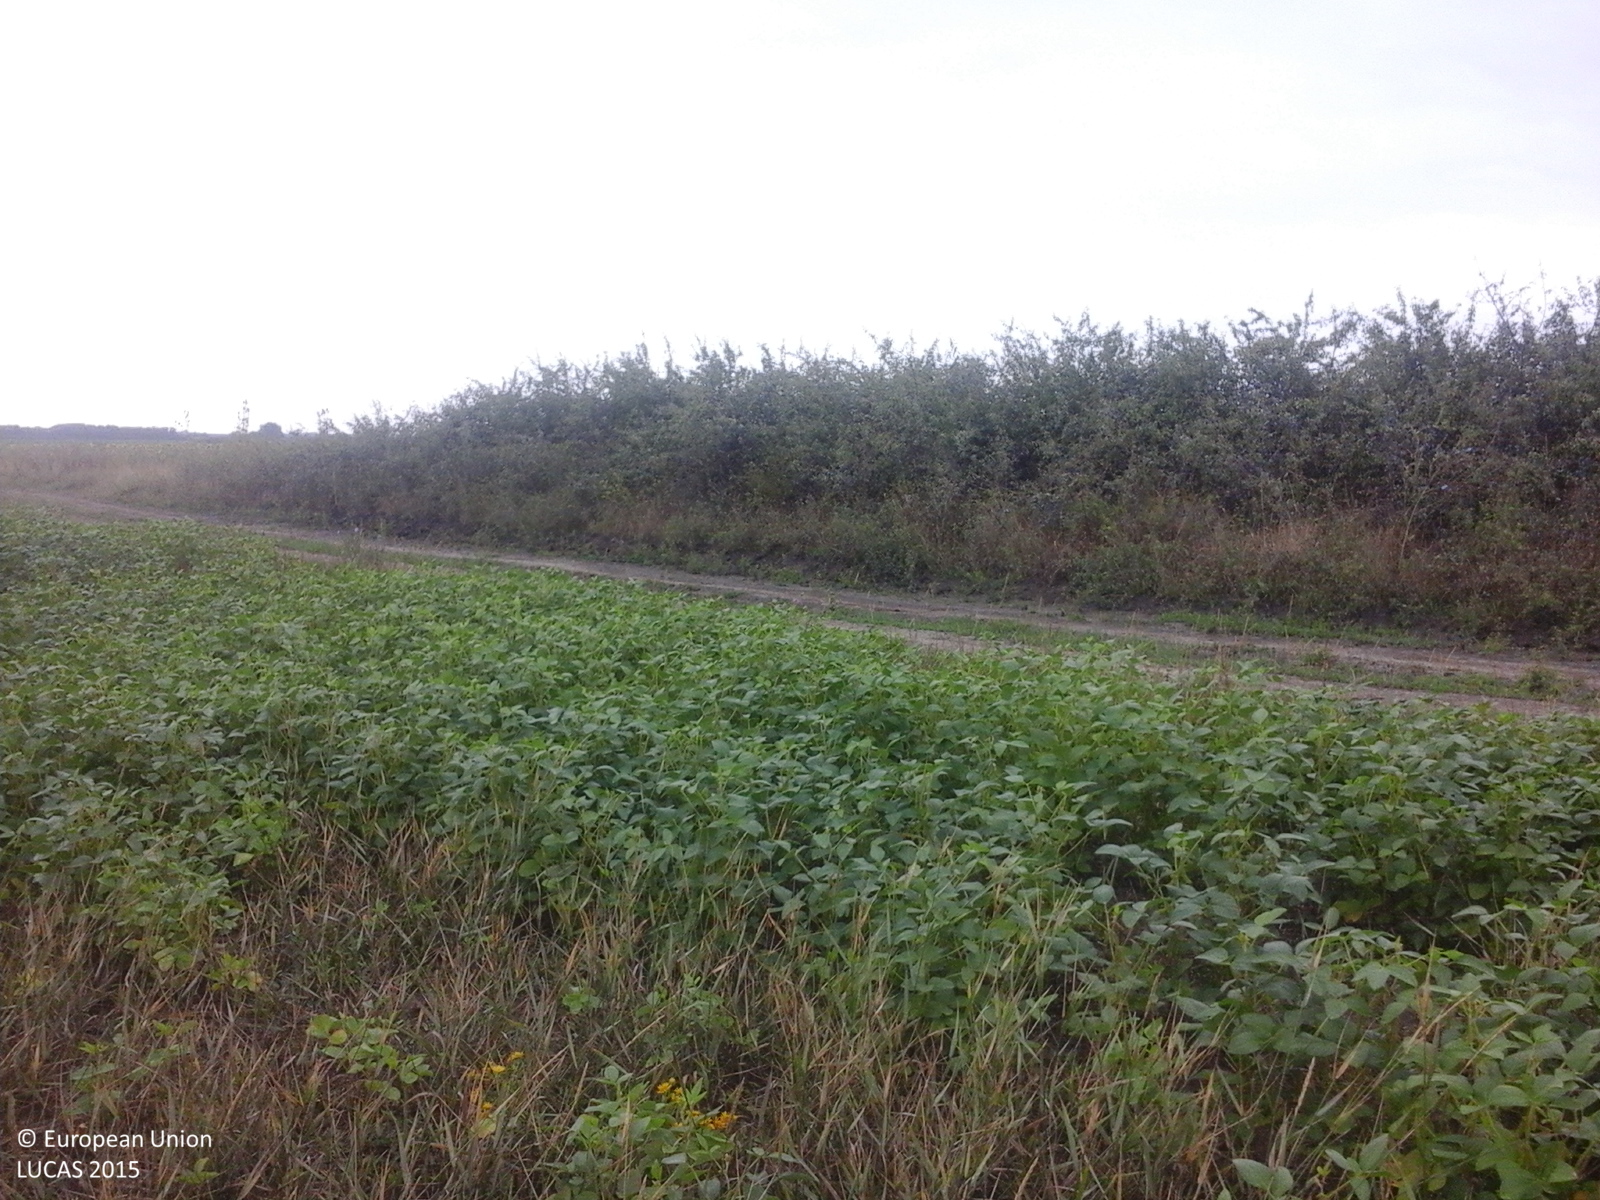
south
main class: Cropland
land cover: Soya
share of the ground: > 75 %
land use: Agriculture (excluding fallow land and kitchen gardens)
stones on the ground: < 10 %
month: August
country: RO
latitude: 45.3853
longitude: 20.9710
